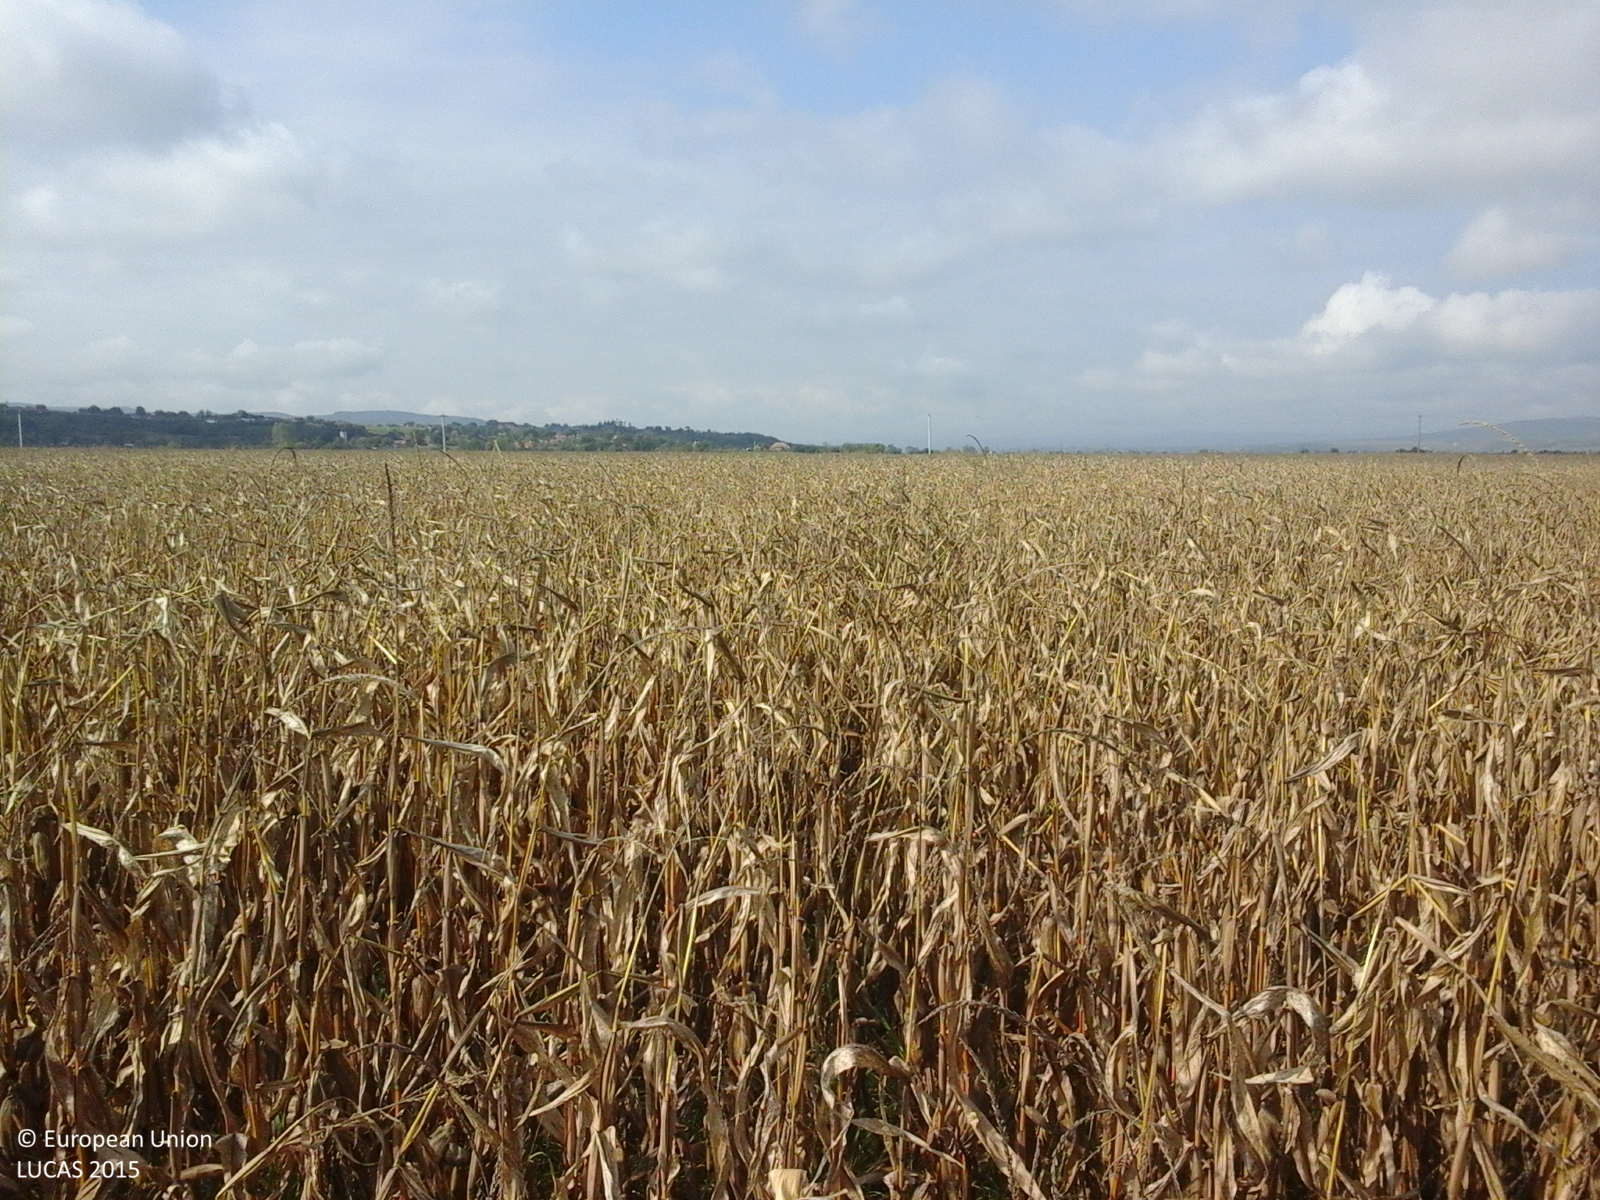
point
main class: Cropland
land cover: Maize
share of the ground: > 75 %
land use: Agriculture (excluding fallow land and kitchen gardens)
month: October
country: RO
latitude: 46.4170
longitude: 23.9577
